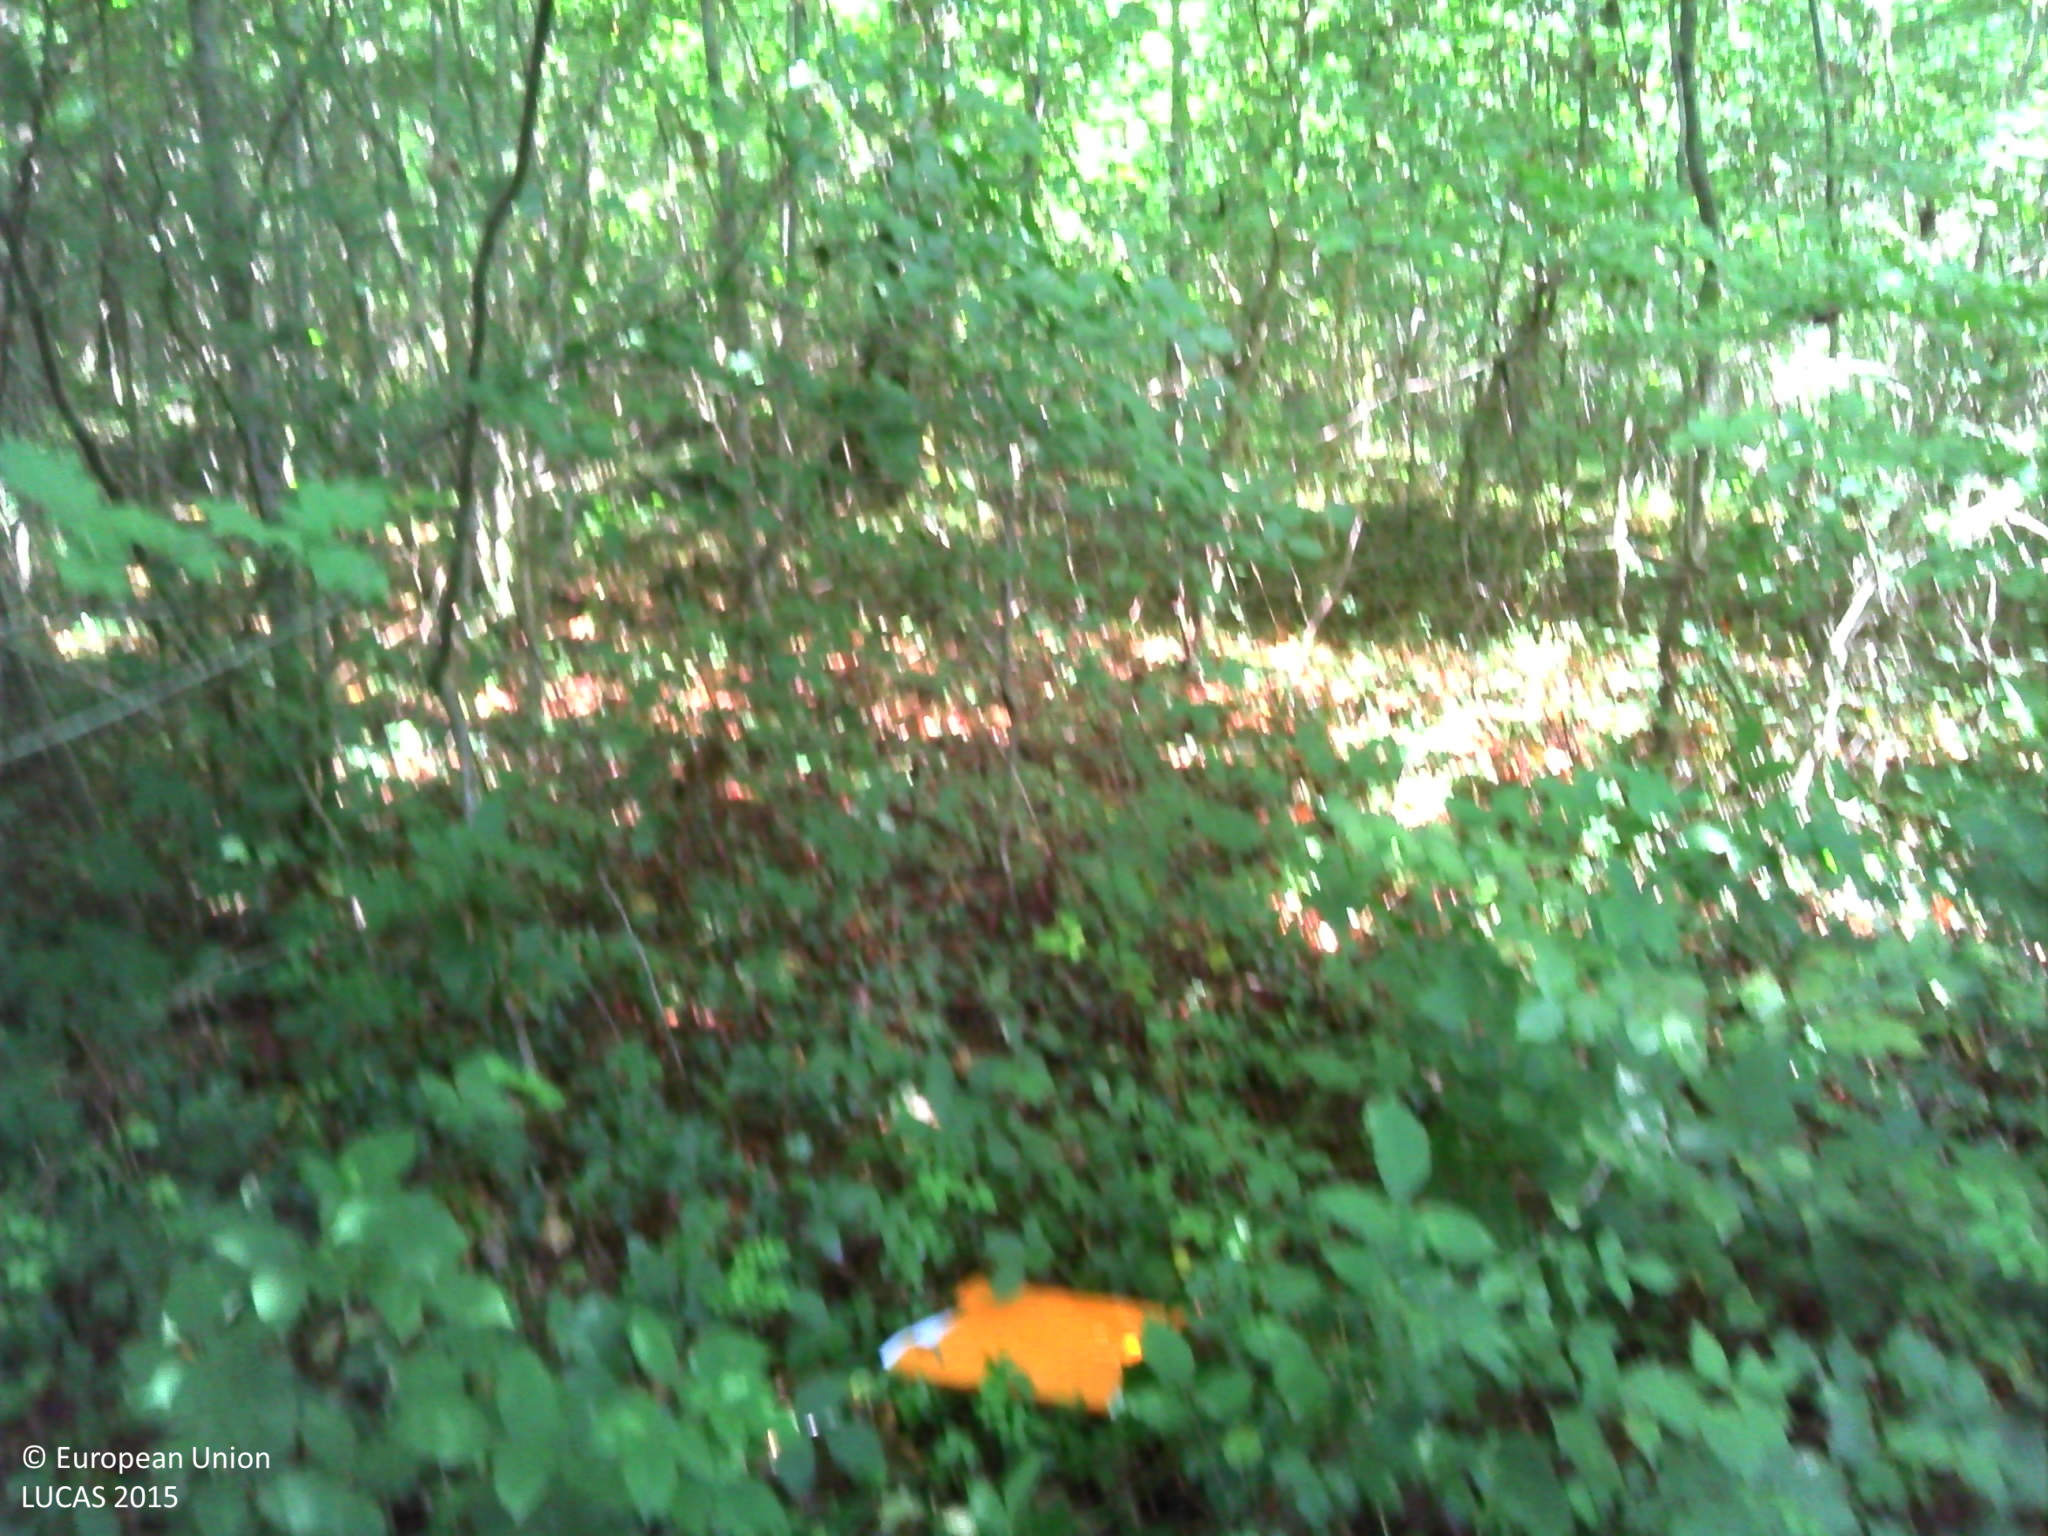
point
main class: Woodland
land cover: Broadleaved woodland
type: mesophytic deciduous forest
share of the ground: > 75 %
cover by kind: broadleaved forest trees 100 %
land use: Forestry
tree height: > 5 m
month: August
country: FR
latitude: 47.1276
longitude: 2.1212
